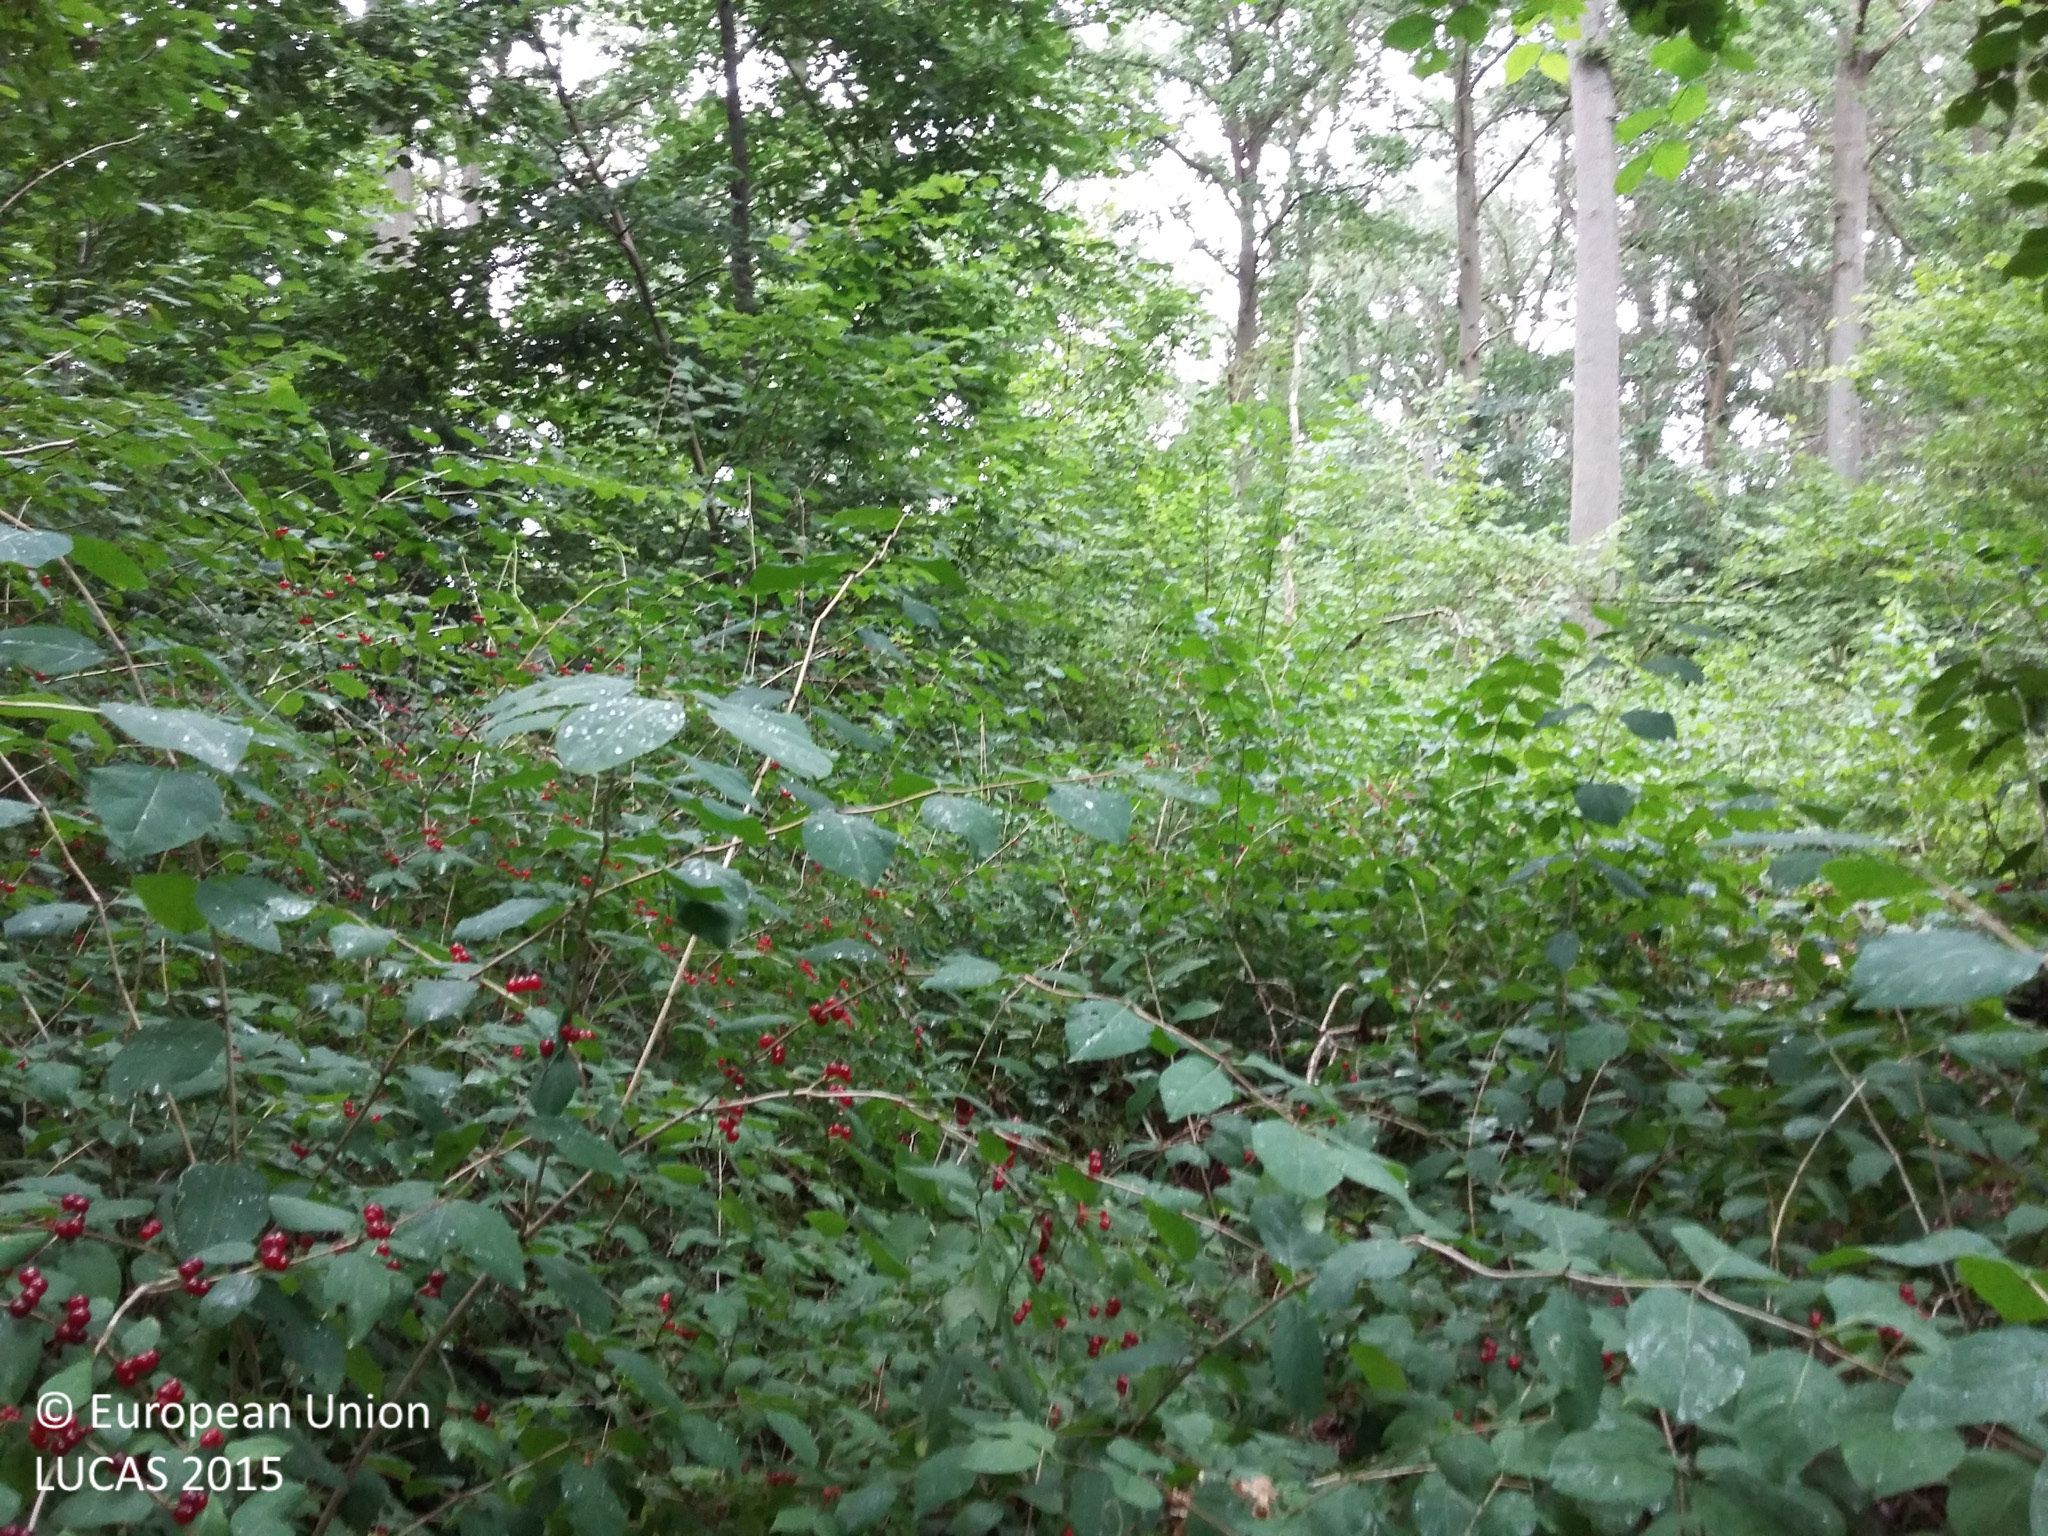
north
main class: Woodland
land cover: Broadleaved woodland
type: mesophytic deciduous forest
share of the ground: > 75 %
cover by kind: broadleaved forest trees 65 %, shrubs 35 %
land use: Forestry
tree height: > 5 m
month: August
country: DK
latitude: 55.3245
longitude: 12.1576
